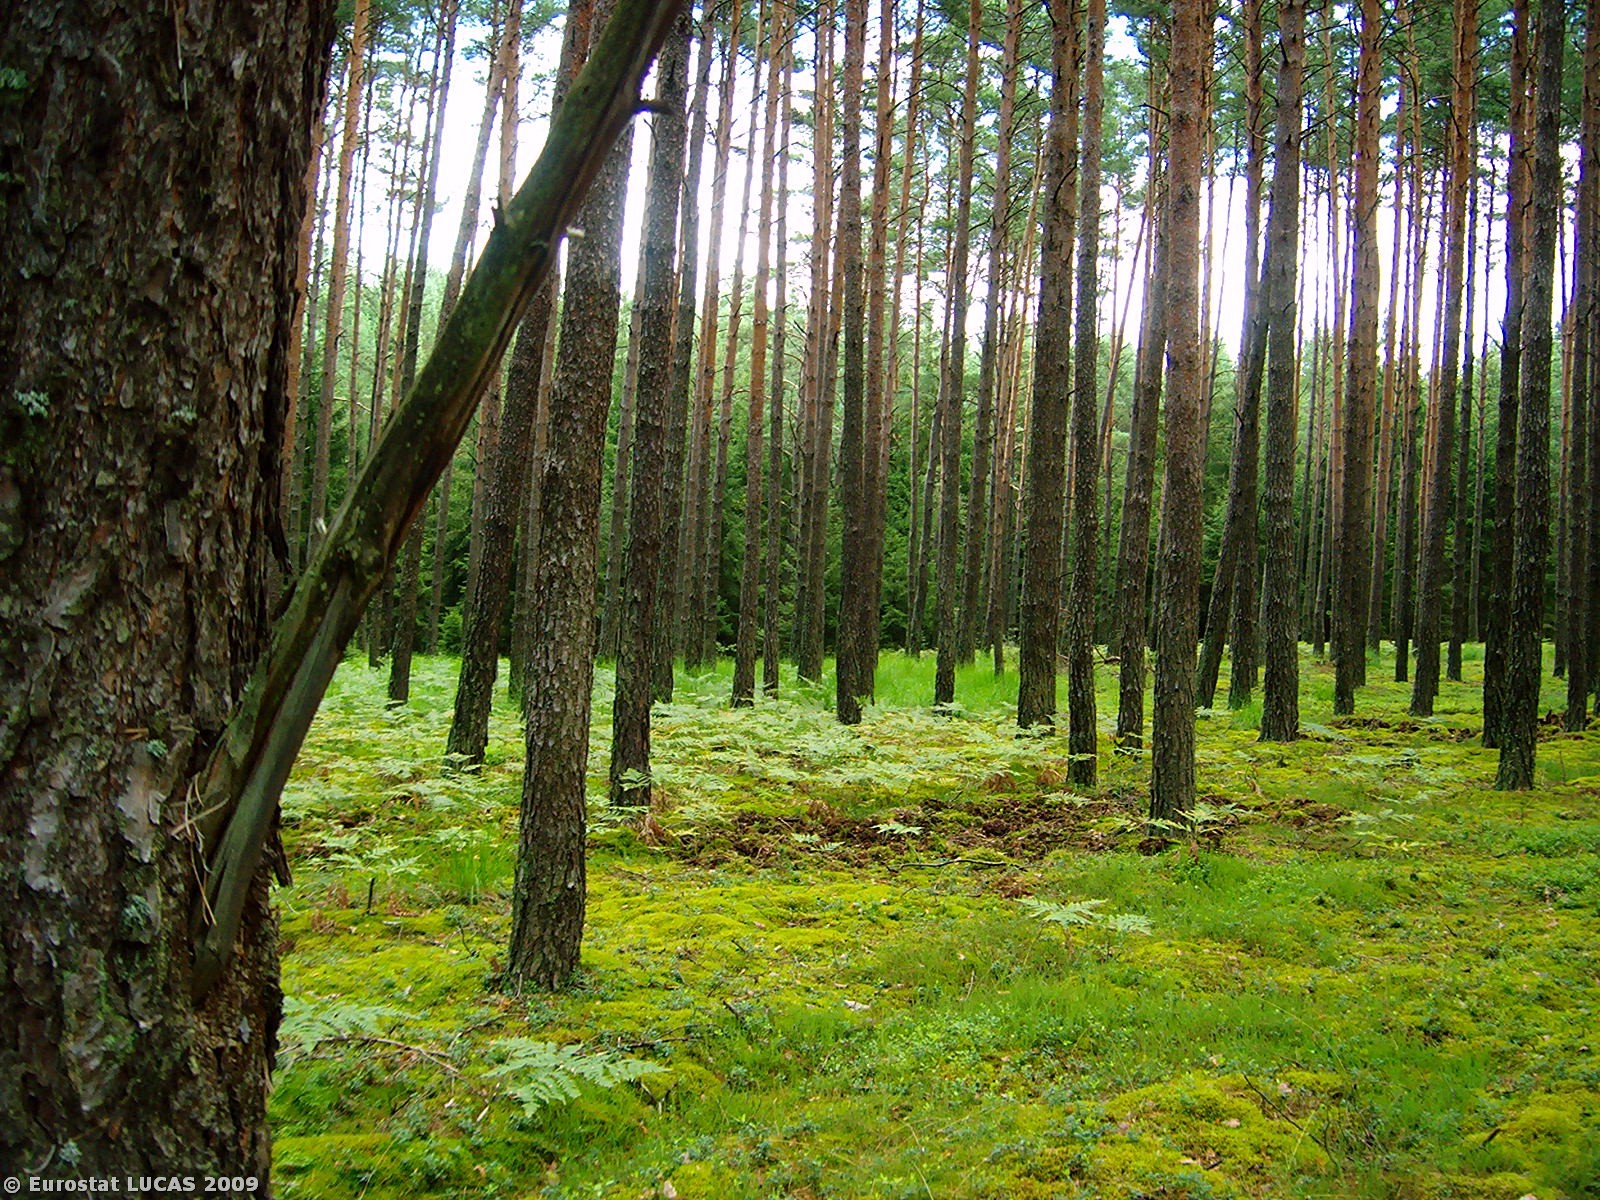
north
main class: Woodland
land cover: Coniferous woodland
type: hemiboreal forest and nemoral coniferous forest and mixed broadleaved-coniferous forest
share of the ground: 50 - 75 %
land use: Forestry
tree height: > 5 m
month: July
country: PL
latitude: 52.7183
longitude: 15.8823
